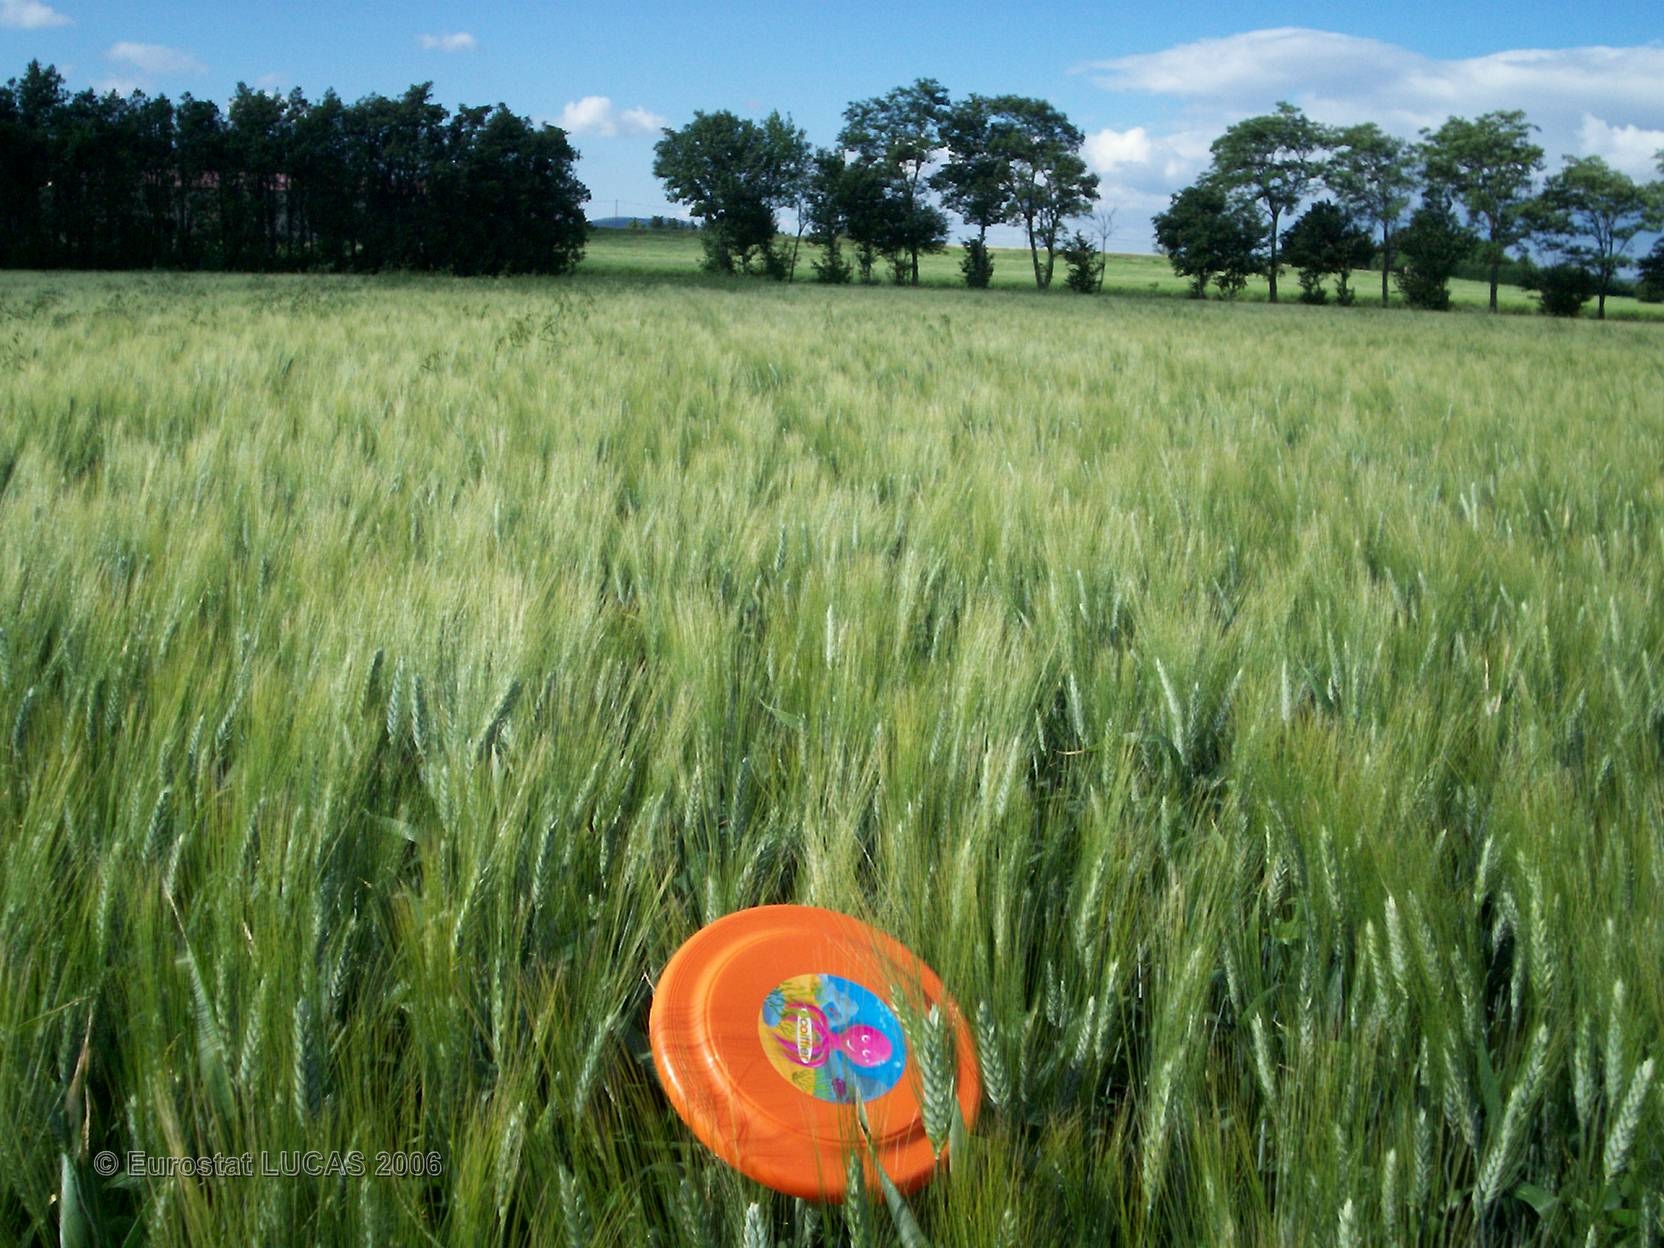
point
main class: Cropland
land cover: Durum wheat
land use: Agriculture (excluding fallow land and kitchen gardens)
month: May
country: FR
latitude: 44.5831
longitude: 4.8302
